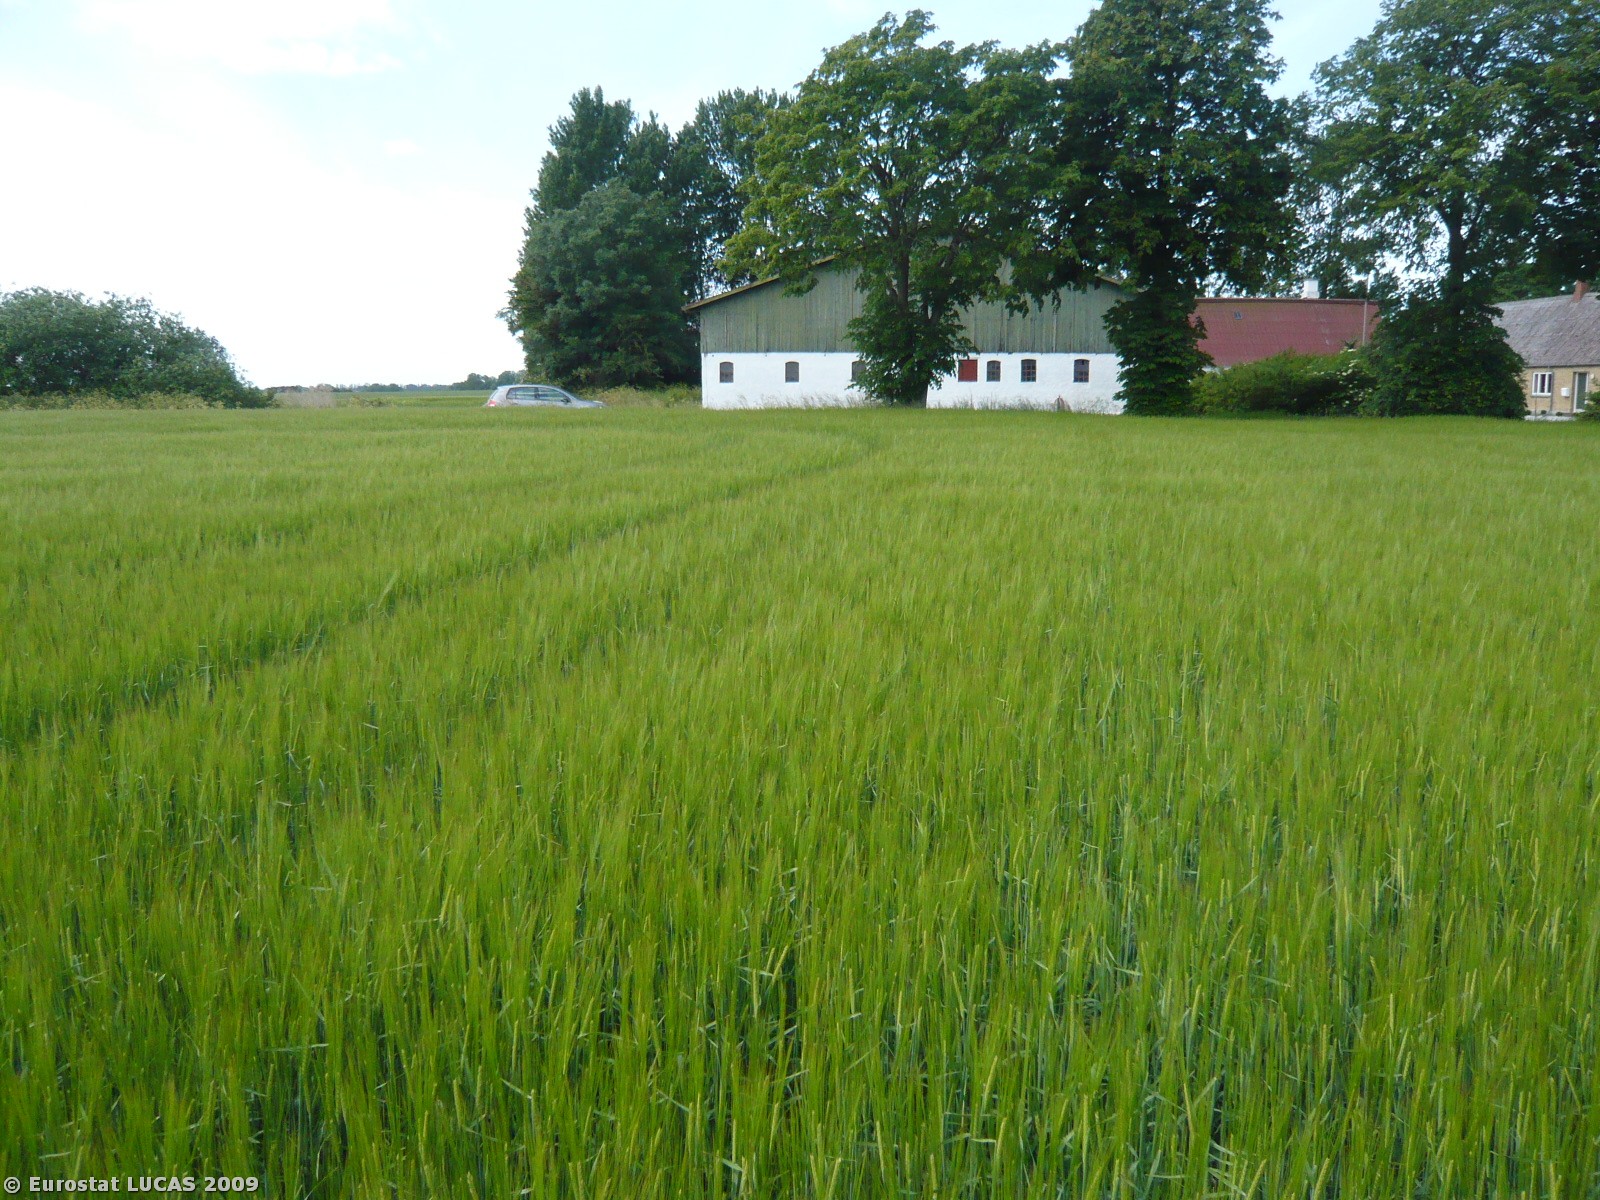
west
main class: Cropland
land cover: Barley
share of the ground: > 75 %
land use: Agriculture (excluding fallow land and kitchen gardens)
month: June
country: DK
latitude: 54.7986
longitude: 11.1347
